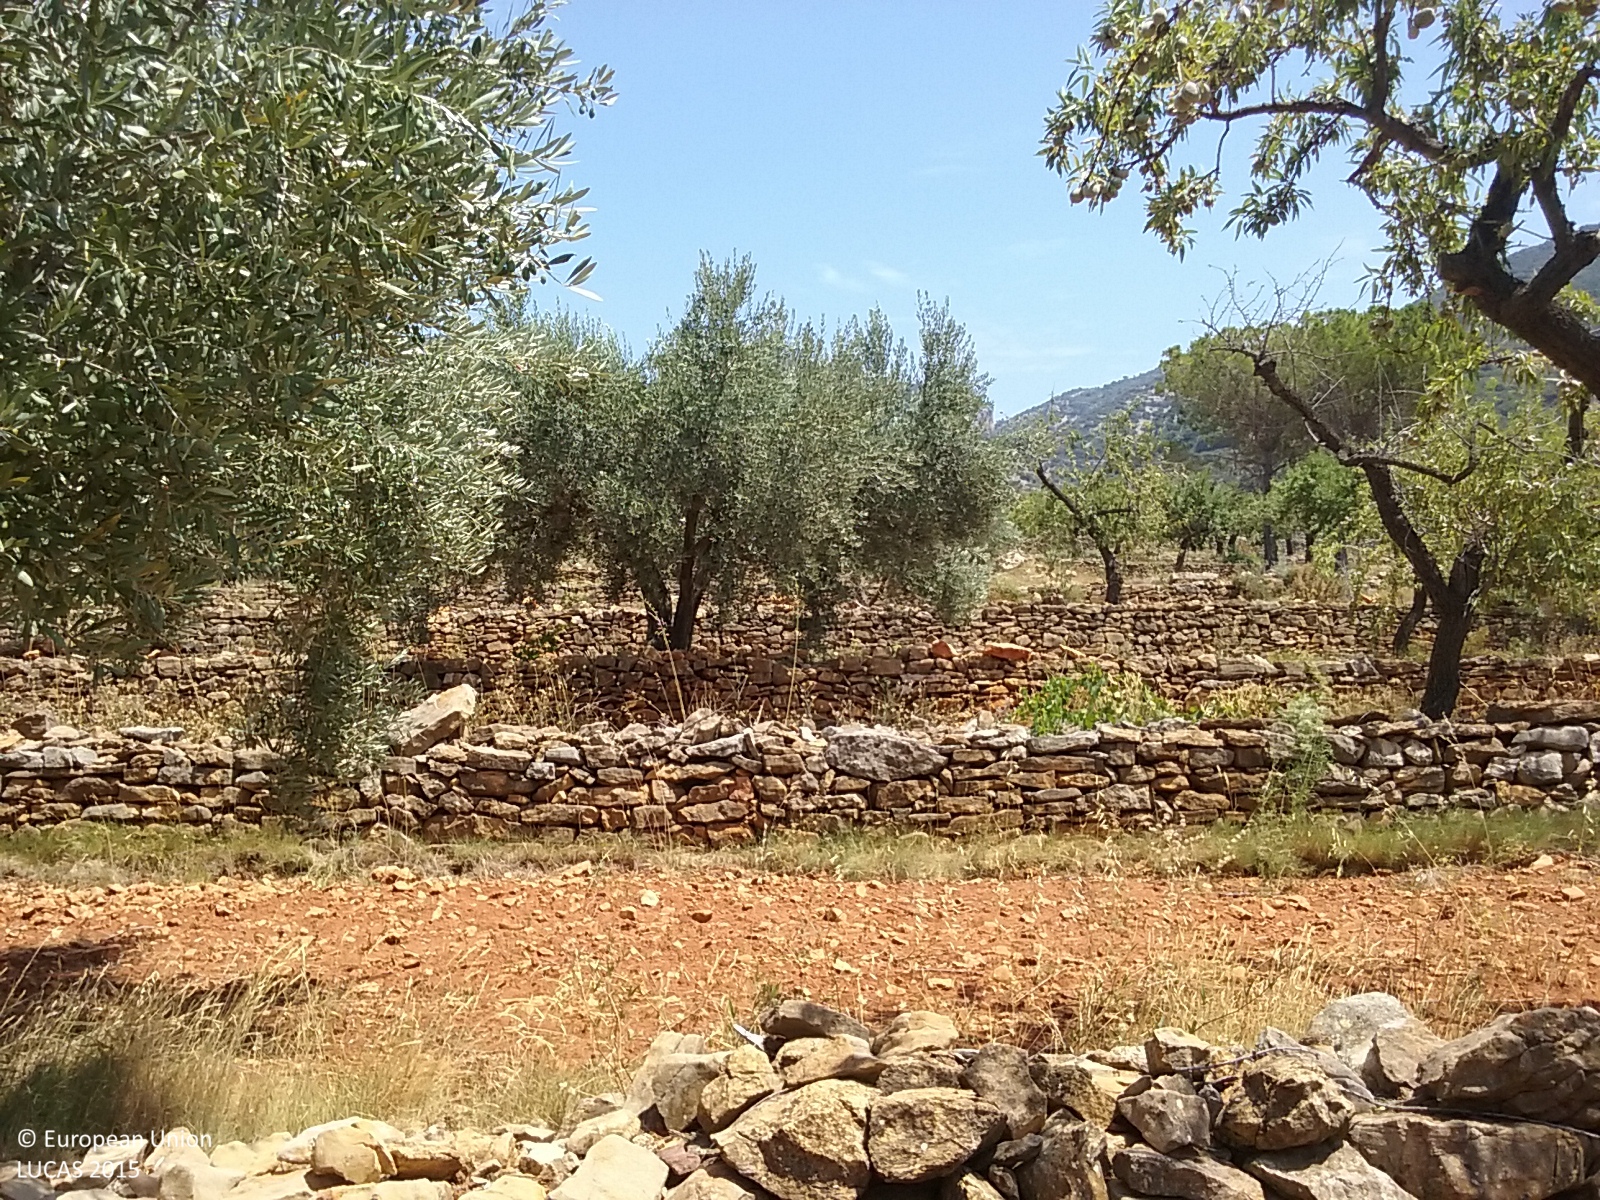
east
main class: Cropland
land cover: Nuts trees
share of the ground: 25 - 50 %
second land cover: Other bare soil
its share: > 75 %
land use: Agriculture (excluding fallow land and kitchen gardens)
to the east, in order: Nuts trees; Other bare soil; Dry stone walls; Nuts trees; Dry stone walls; Olive groves; Dry stone walls; Olive groves; Dry stone walls; Shrubland with sparse tree cover; Dry stone walls; Nuts trees; Dry stone walls; Nuts trees; Dry stone walls; Nuts trees; Dry stone walls; Nuts trees; Dry stone walls; Shrubland with sparse tree cover; Dry stone walls; Nuts trees; Dry stone walls; Nuts trees; Dry stone walls; Nuts trees; Dry stone walls; Nuts trees; Dry stone walls; Nuts trees; Dry stone walls; Nuts trees; Dry stone walls; Nuts trees; Dry stone walls; Nuts trees; Dry stone walls; Nuts trees; Dry stone walls; Nuts trees; Dry stone walls; Tracks; Shrubland without tree cover; Paved roads, cycling and walking lanes; Shrubland without tree cover
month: July
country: ES
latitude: 40.2976
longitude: -0.0391
